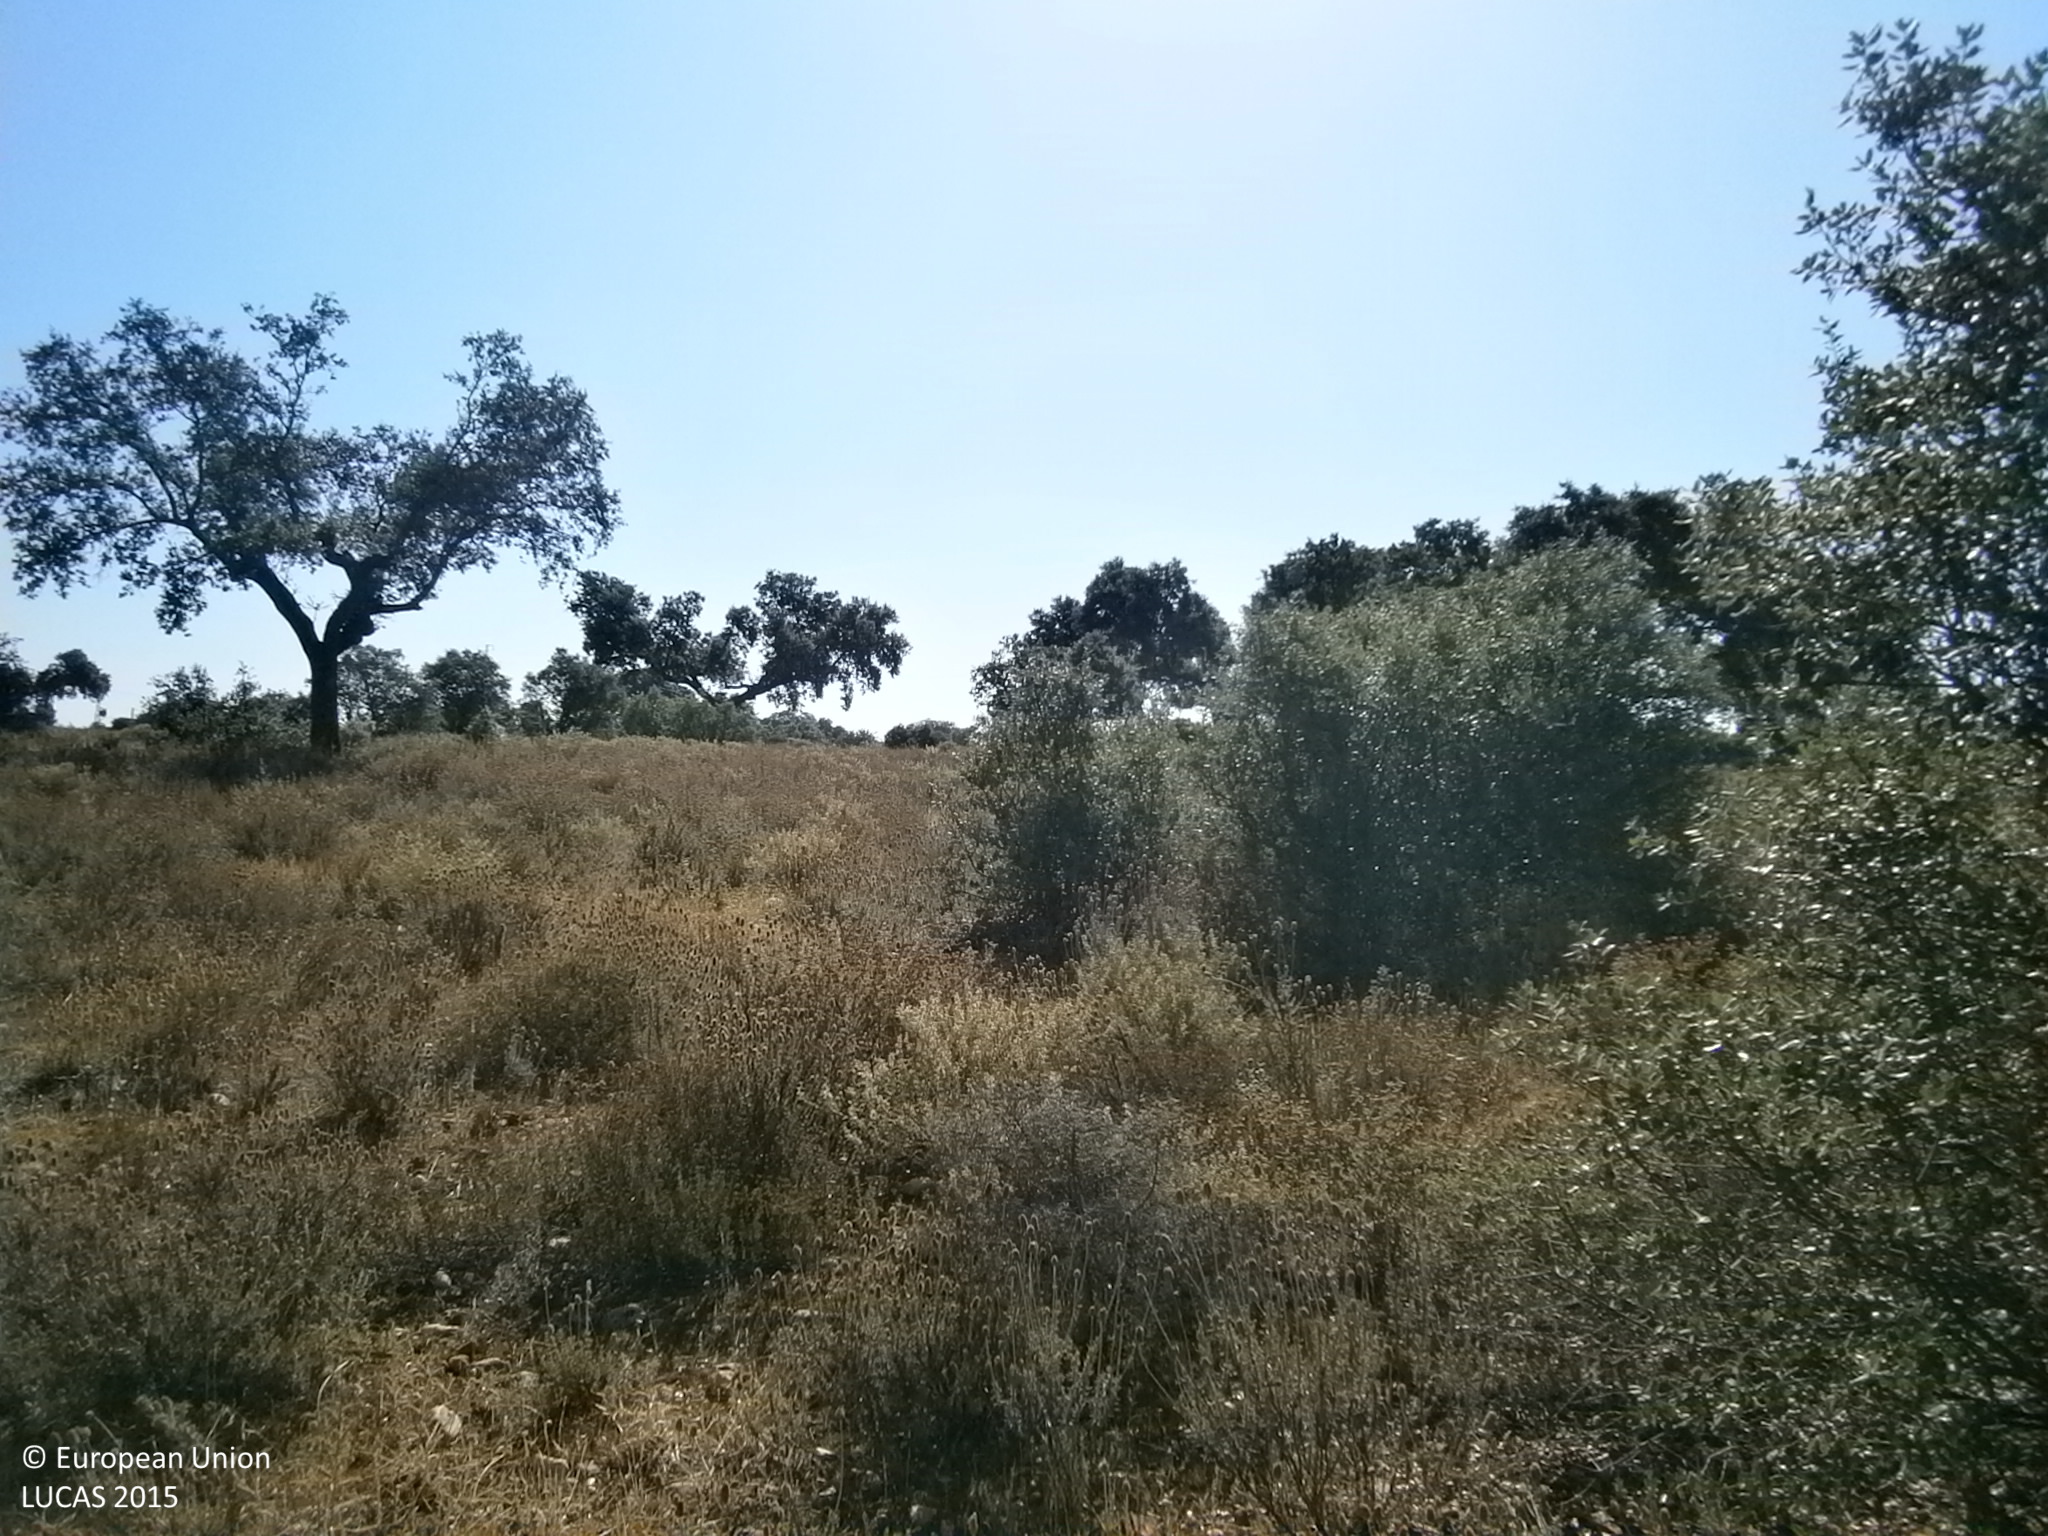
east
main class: Woodland
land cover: Broadleaved woodland
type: broadleaved evergreen forest
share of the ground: > 75 %
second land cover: Spontaneously vegetated surfaces
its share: > 75 %
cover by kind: broadleaved forest trees 90 %, unconsolidated bare surface 5 %
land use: Forestry
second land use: Agriculture (excluding fallow land and kitchen gardens)
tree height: < 5 m
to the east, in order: Broadleaved woodland; Spontaneously vegetated surfaces; Grassland with sparse tree/shrub cover; Fences; Paved roads, cycling and walking lanes; Fences; Electric lines; Broadleaved woodland
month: June
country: ES
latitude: 38.8444
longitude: -6.9006
